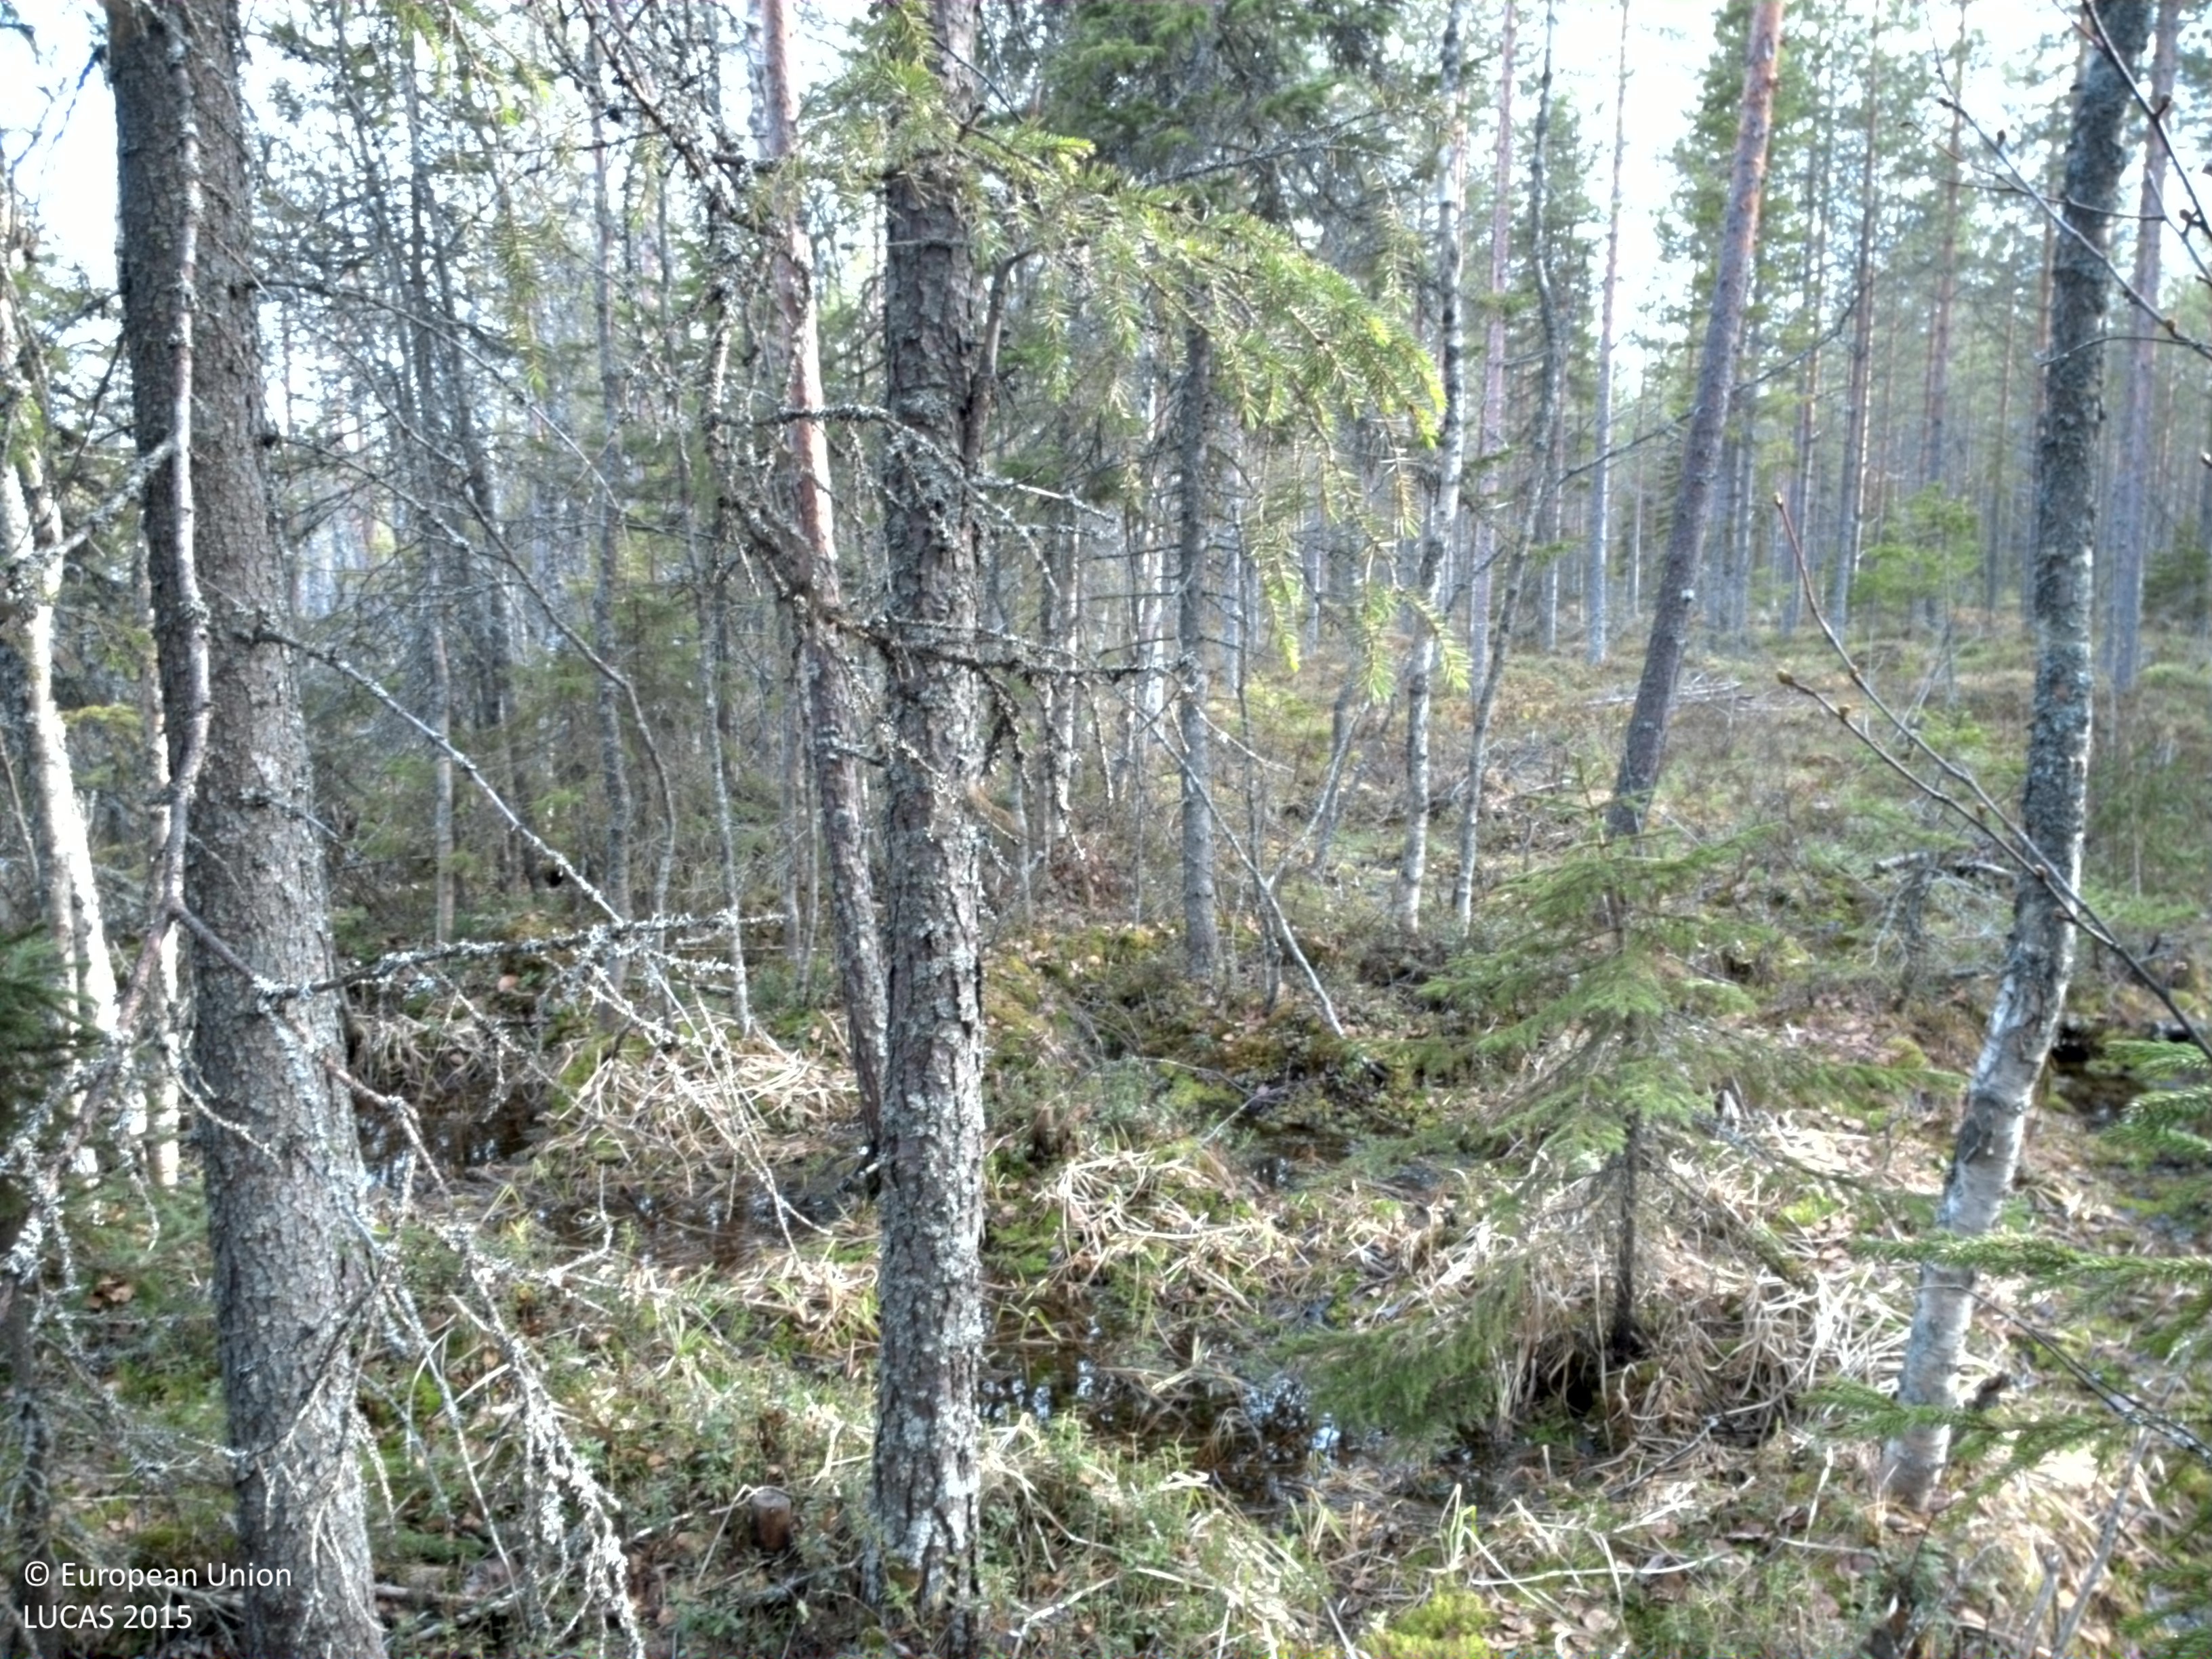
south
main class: Woodland
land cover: Pine dominated mixed woodland
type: mire and swamp forests
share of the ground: > 75 %
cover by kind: coniferous forest trees 65 %, broadleaved forest trees 25 %, shrubs 10 %
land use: Forestry
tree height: > 5 m
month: May
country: SE
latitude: 65.8484
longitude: 23.6409
